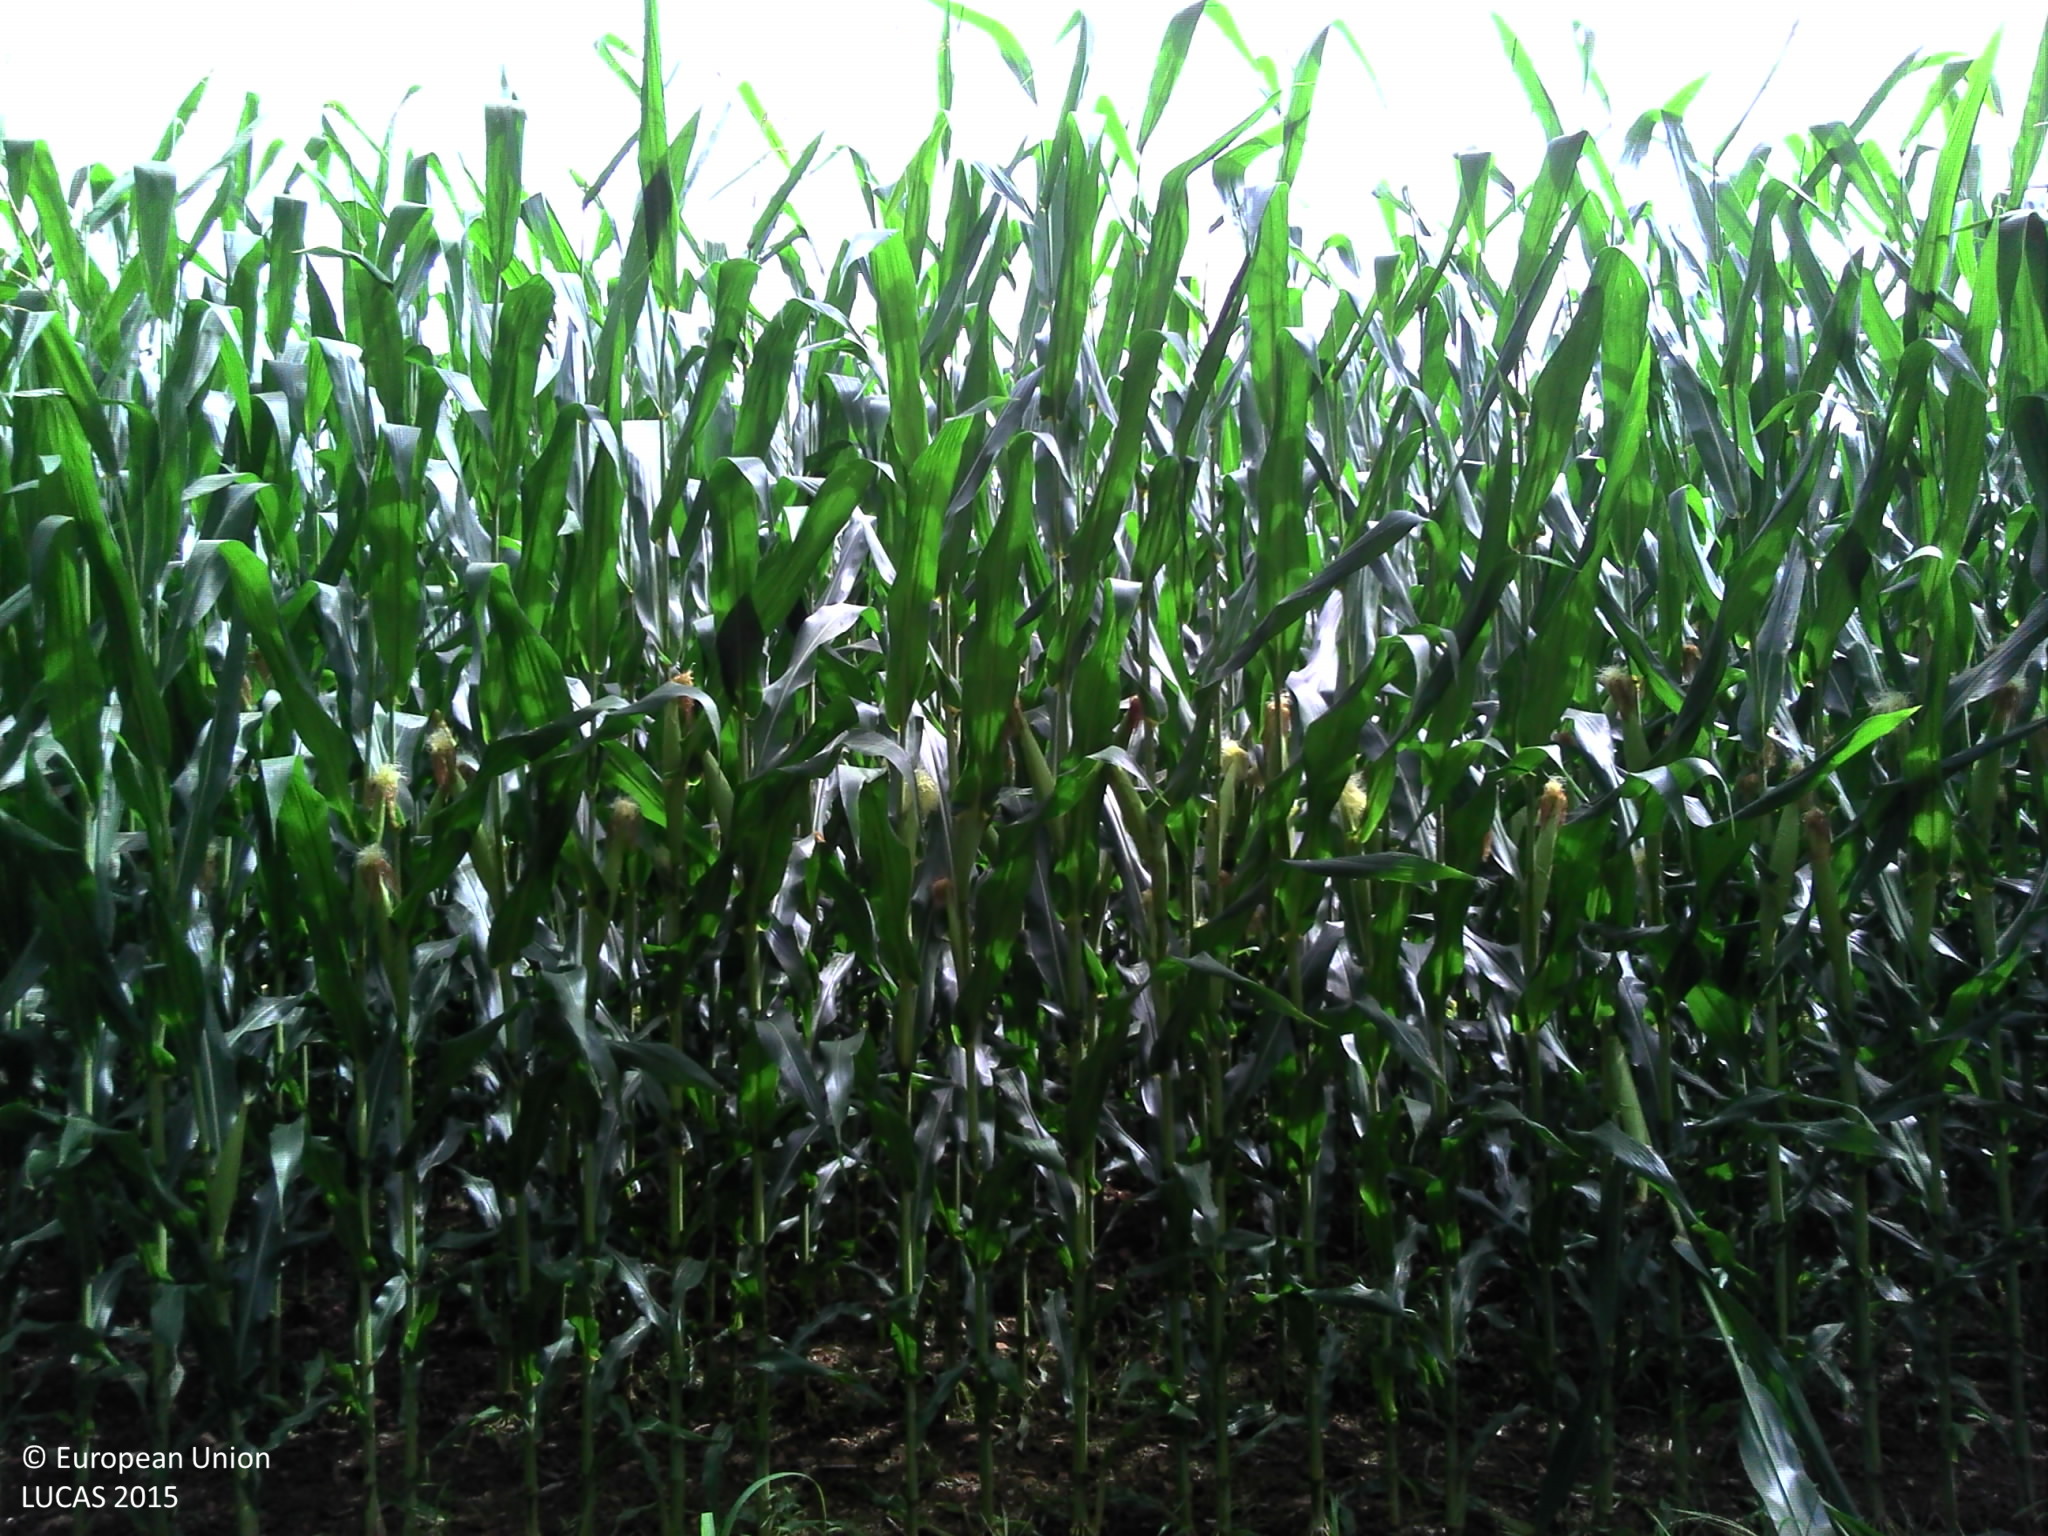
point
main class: Cropland
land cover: Maize
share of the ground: > 75 %
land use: Agriculture (excluding fallow land and kitchen gardens)
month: July
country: FR
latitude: 46.3781
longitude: 0.2693
